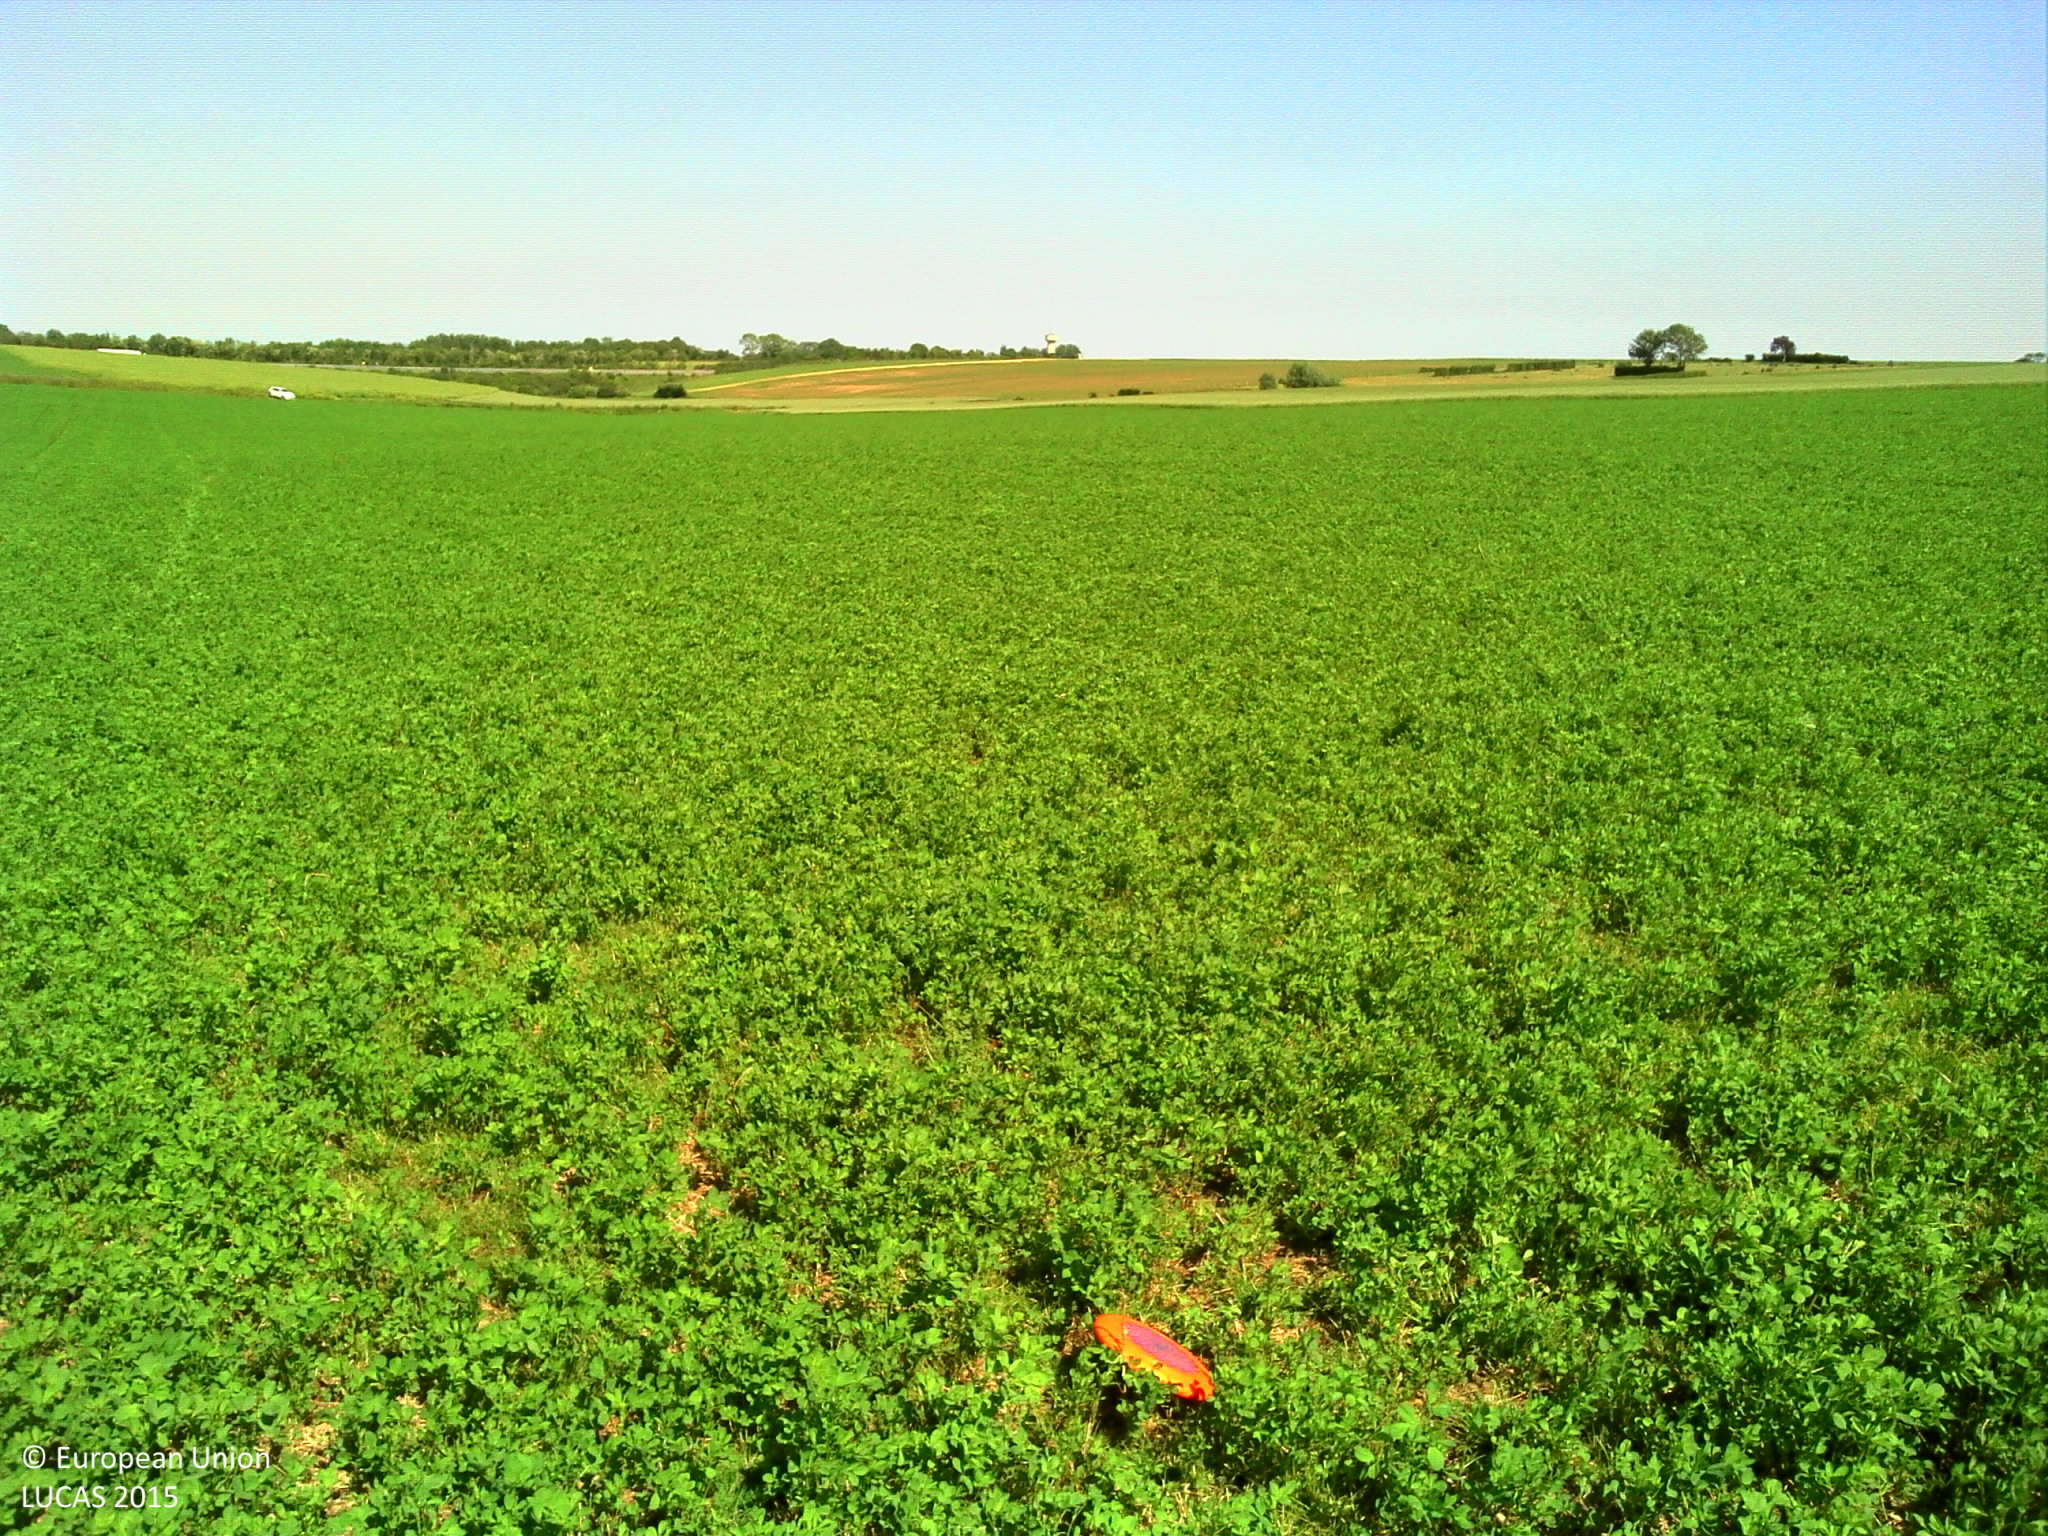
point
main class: Cropland
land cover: Lucerne
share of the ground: > 75 %
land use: Agriculture (excluding fallow land and kitchen gardens)
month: June
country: FR
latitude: 50.7424
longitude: 2.1200
